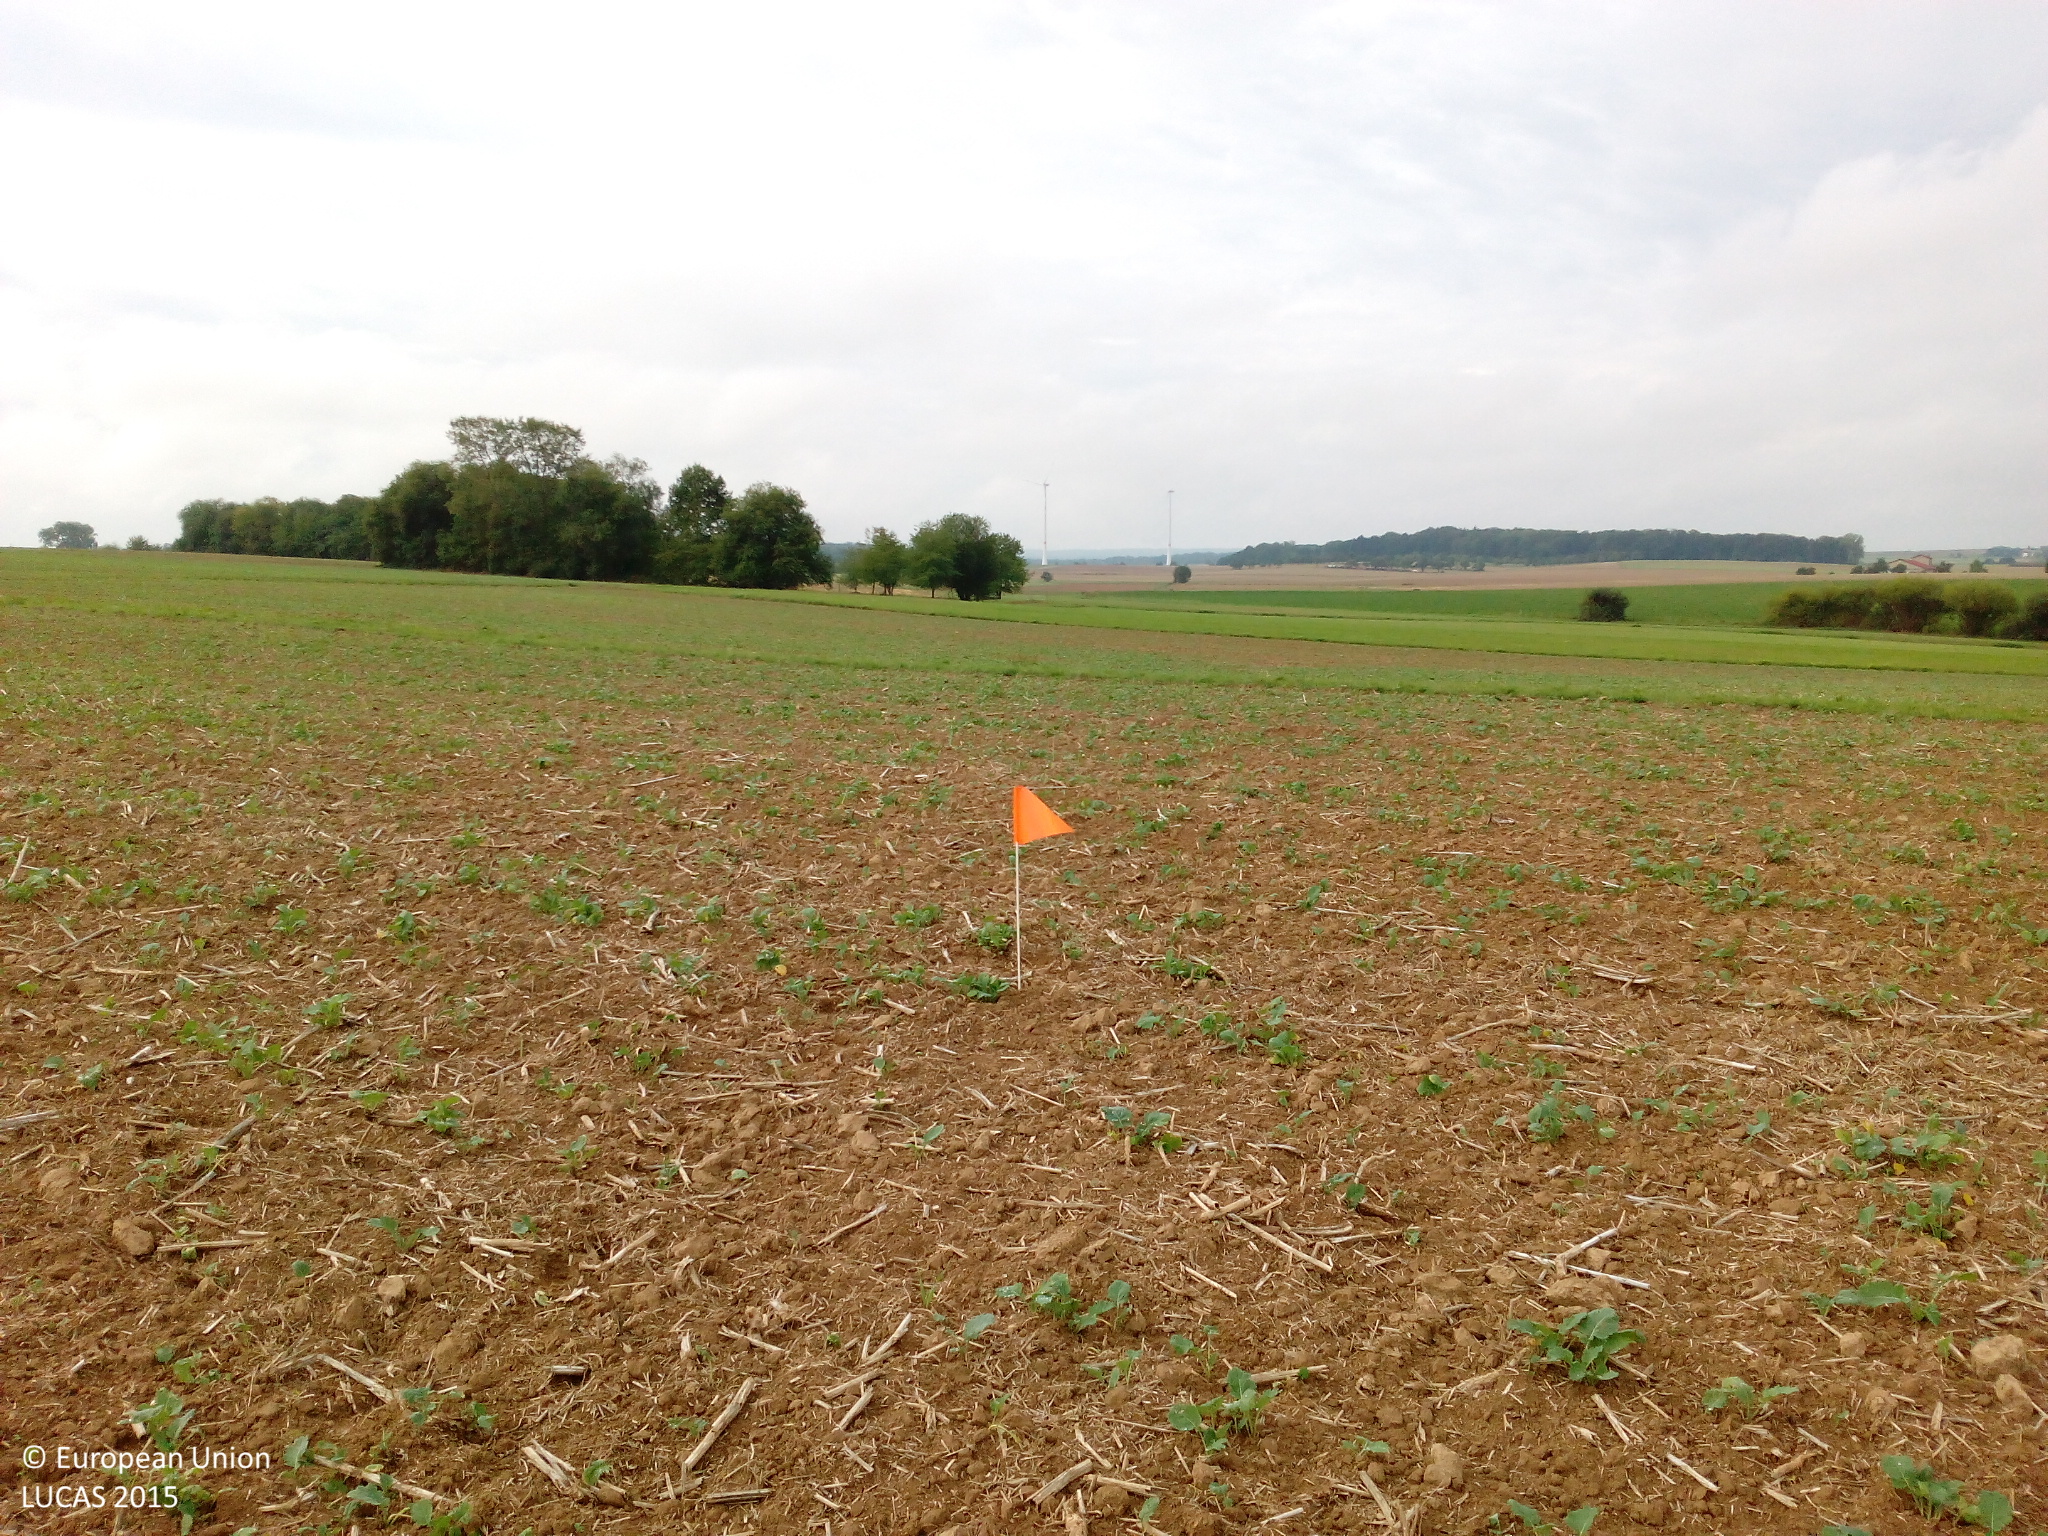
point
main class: Cropland
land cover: Rape and turnip rape
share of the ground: < 10 %
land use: Agriculture (excluding fallow land and kitchen gardens)
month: September
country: DE
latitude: 49.7151
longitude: 9.4038
